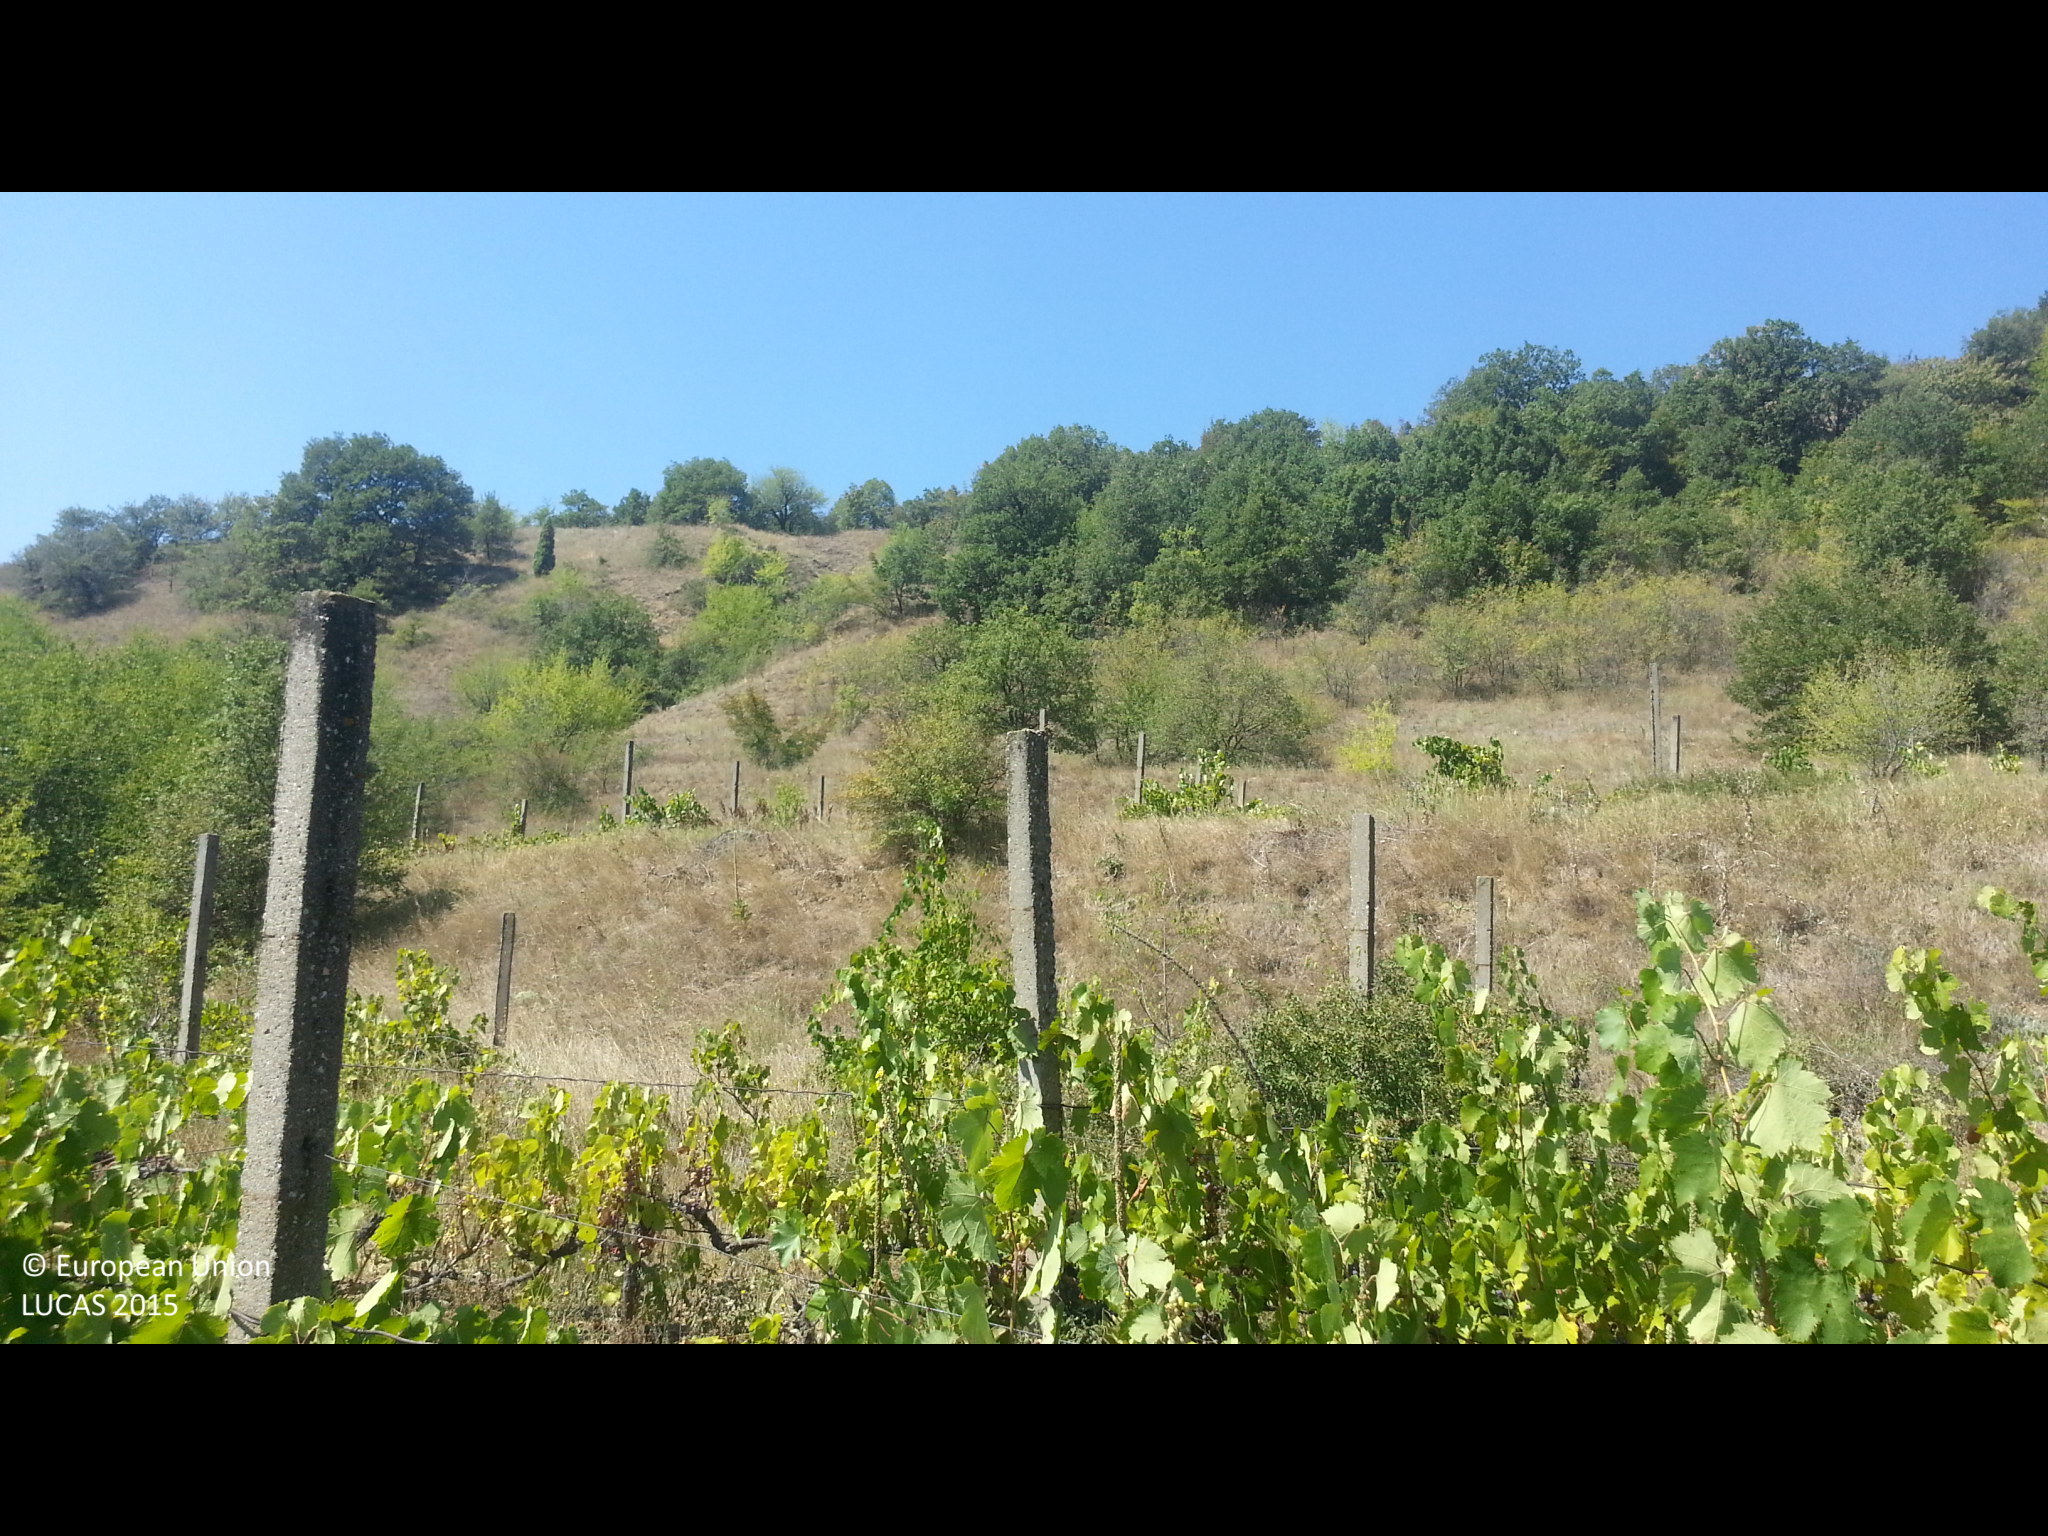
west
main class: Cropland
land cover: Vineyards
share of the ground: 25 - 50 %
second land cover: Spontaneously vegetated surfaces
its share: 50 - 75 %
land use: Agriculture (excluding fallow land and kitchen gardens)
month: September
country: BG
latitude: 42.1726
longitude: 23.0386
